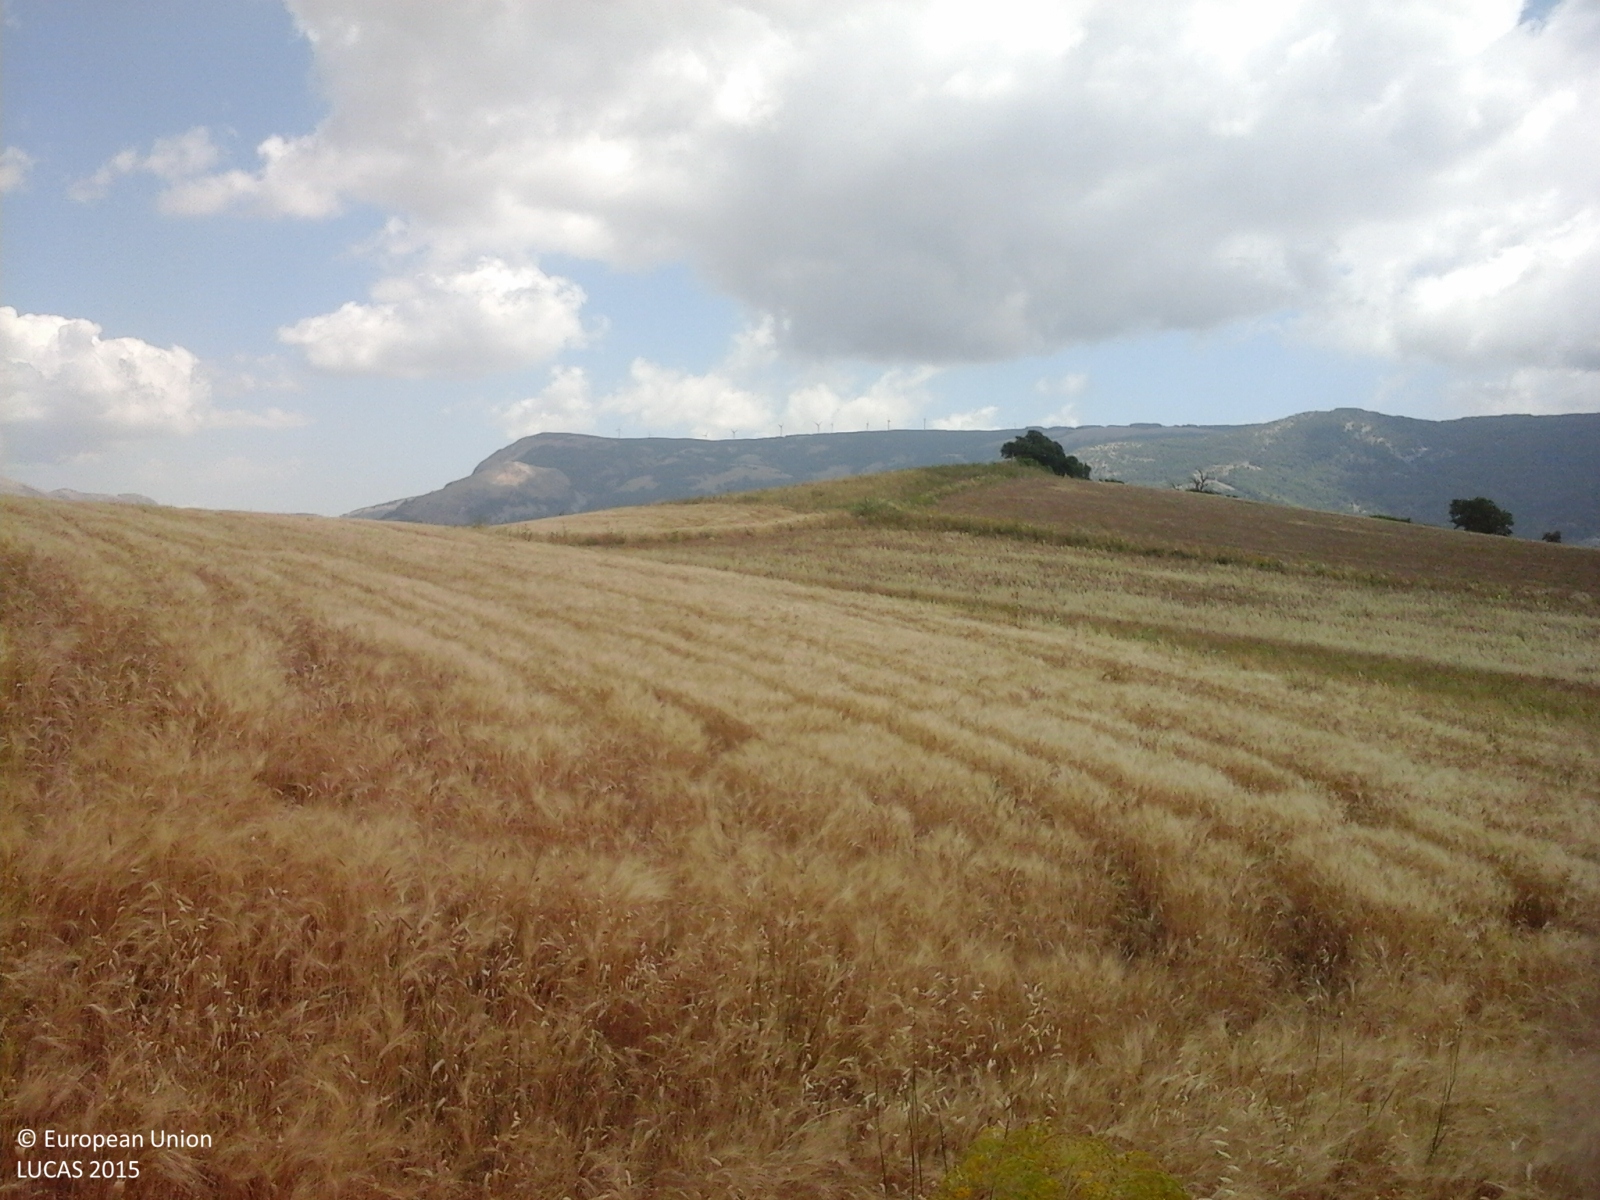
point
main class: Cropland
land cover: Durum wheat
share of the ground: > 75 %
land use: Agriculture (excluding fallow land and kitchen gardens)
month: June
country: IT
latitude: 37.6594
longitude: 13.1391
